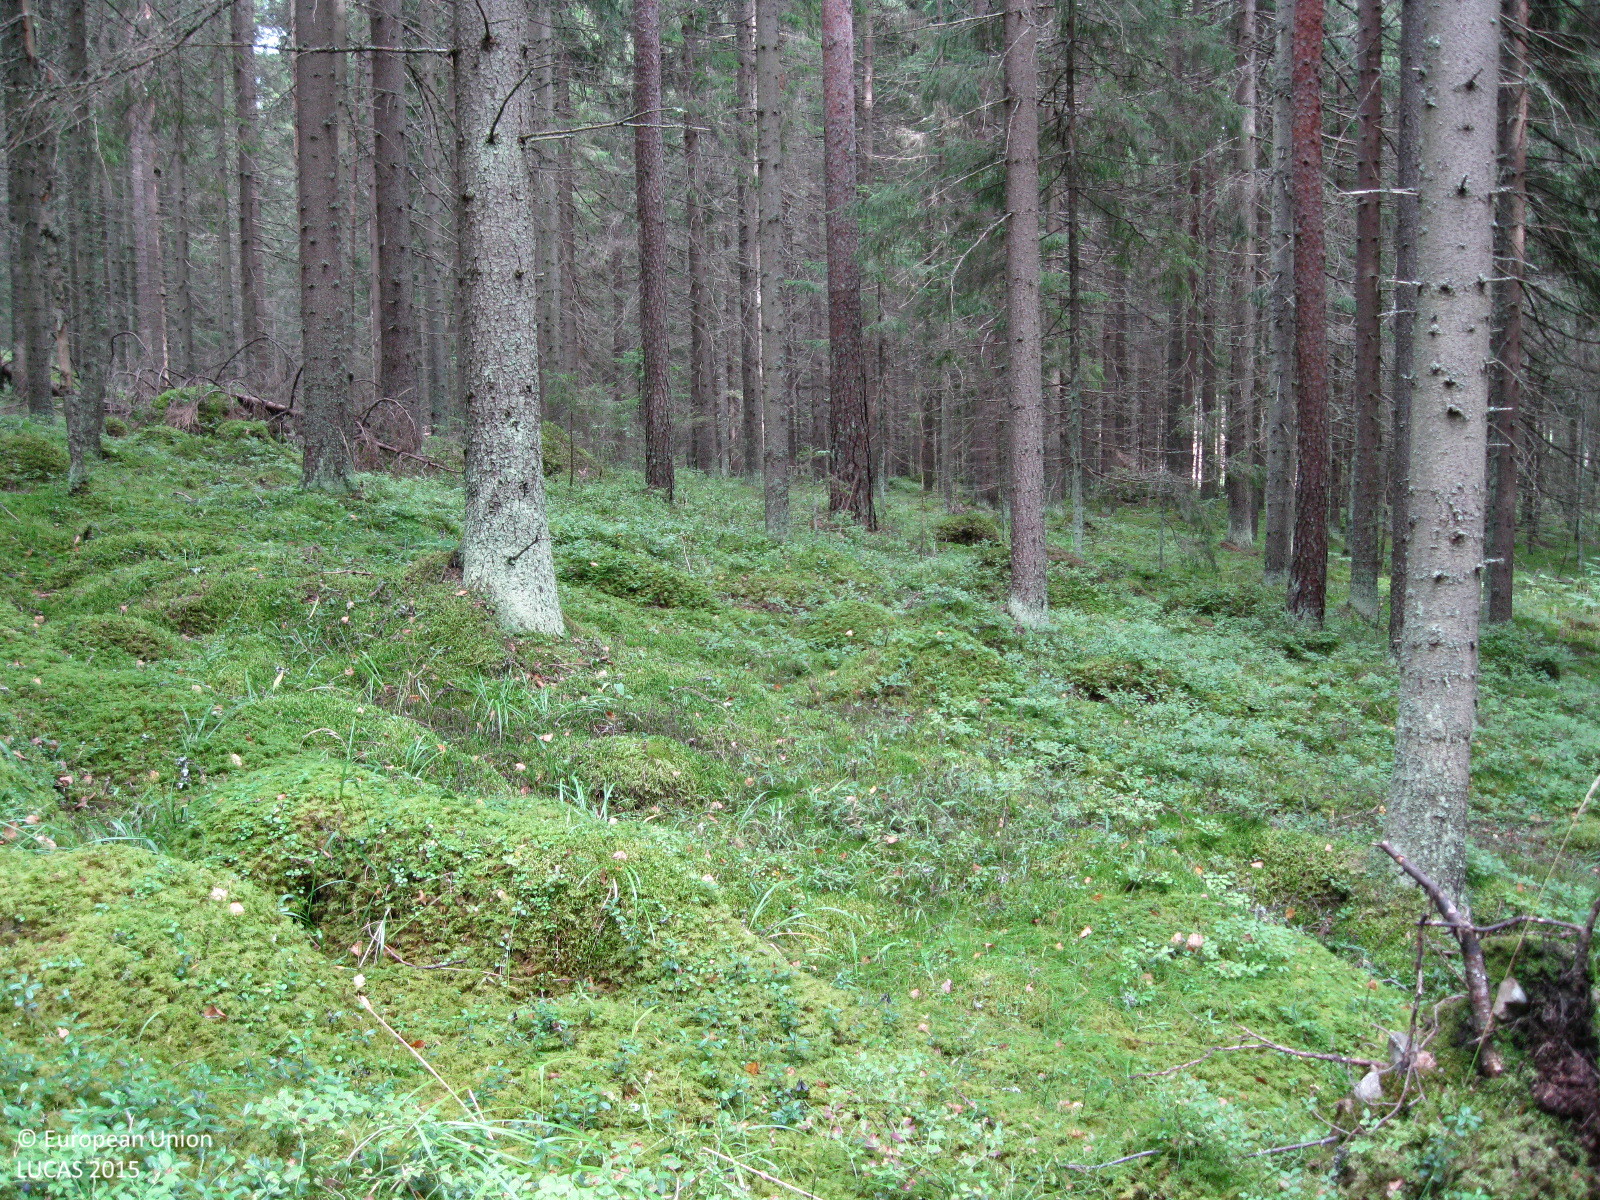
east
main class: Woodland
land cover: Spruce dominated coniferous woodland
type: boreal forest
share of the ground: > 75 %
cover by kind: coniferous forest trees 80 %, shrubs 10 %, broadleaved forest trees 5 %, lichens and mosses 5 %
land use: Forestry
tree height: > 5 m
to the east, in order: Spruce dominated coniferous woodland; Tracks; Spruce dominated mixed woodland; Ditches and canals; Spruce dominated coniferous woodland
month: September
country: FI
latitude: 60.6945
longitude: 25.0064
